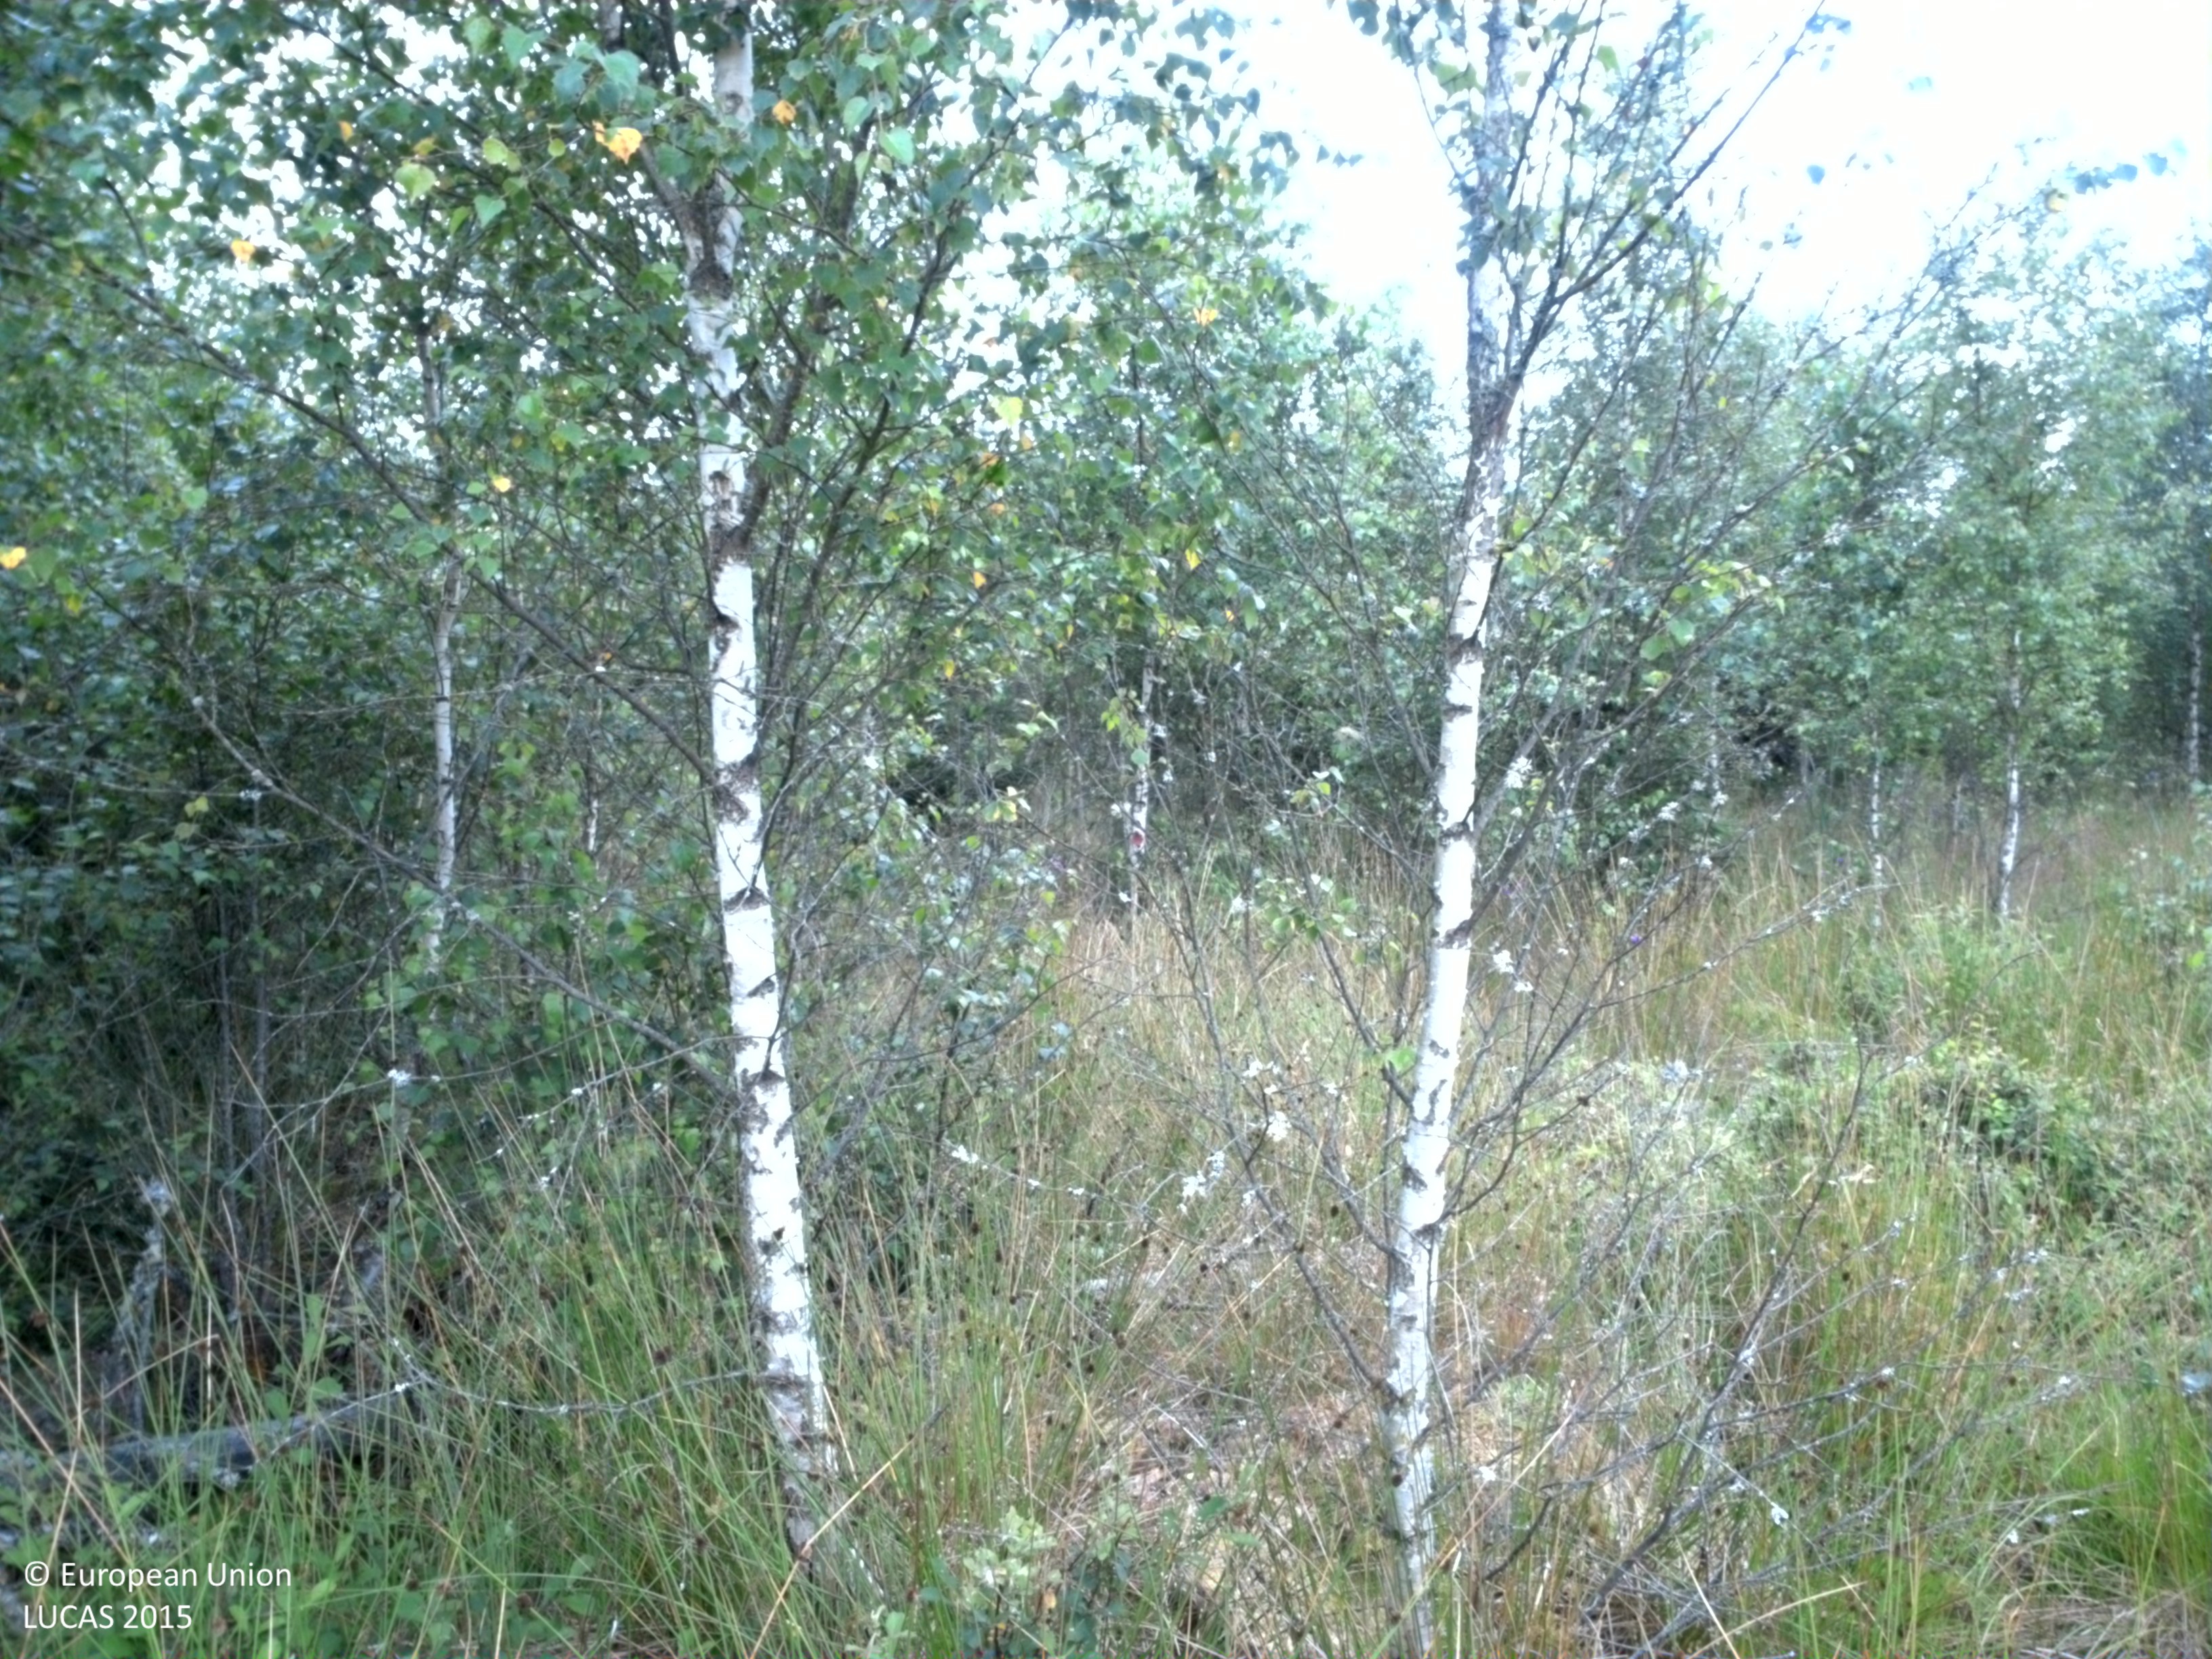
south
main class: Grassland
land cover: Grassland with sparse tree/shrub cover
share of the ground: > 75 %
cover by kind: herbaceous plants 90 %, broadleaved forest trees 5 %, shrubs 5 %
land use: Forestry
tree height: < 5 m
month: July
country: SE
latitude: 58.3396
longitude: 13.3593
